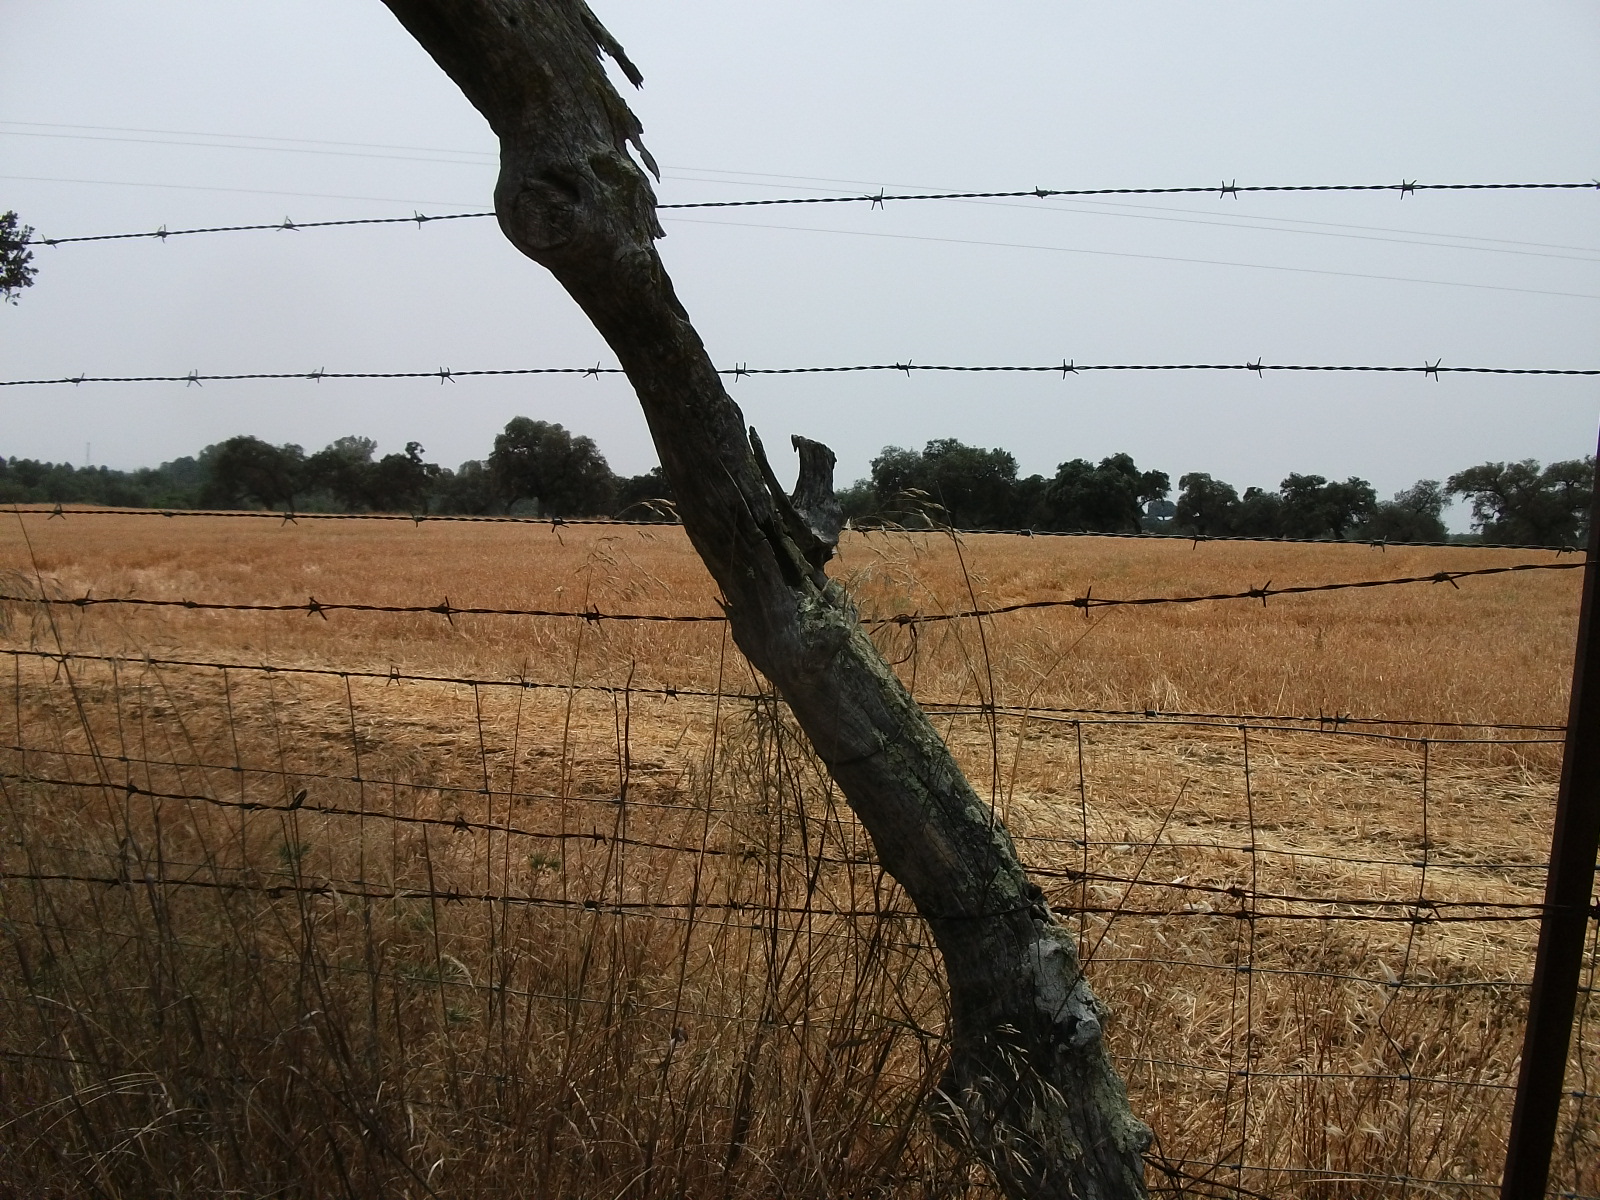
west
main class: Cropland
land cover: Durum wheat
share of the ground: > 75 %
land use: Agriculture (excluding fallow land and kitchen gardens)
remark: Harvested field
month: June
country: ES
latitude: 37.4080
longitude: -6.8849
